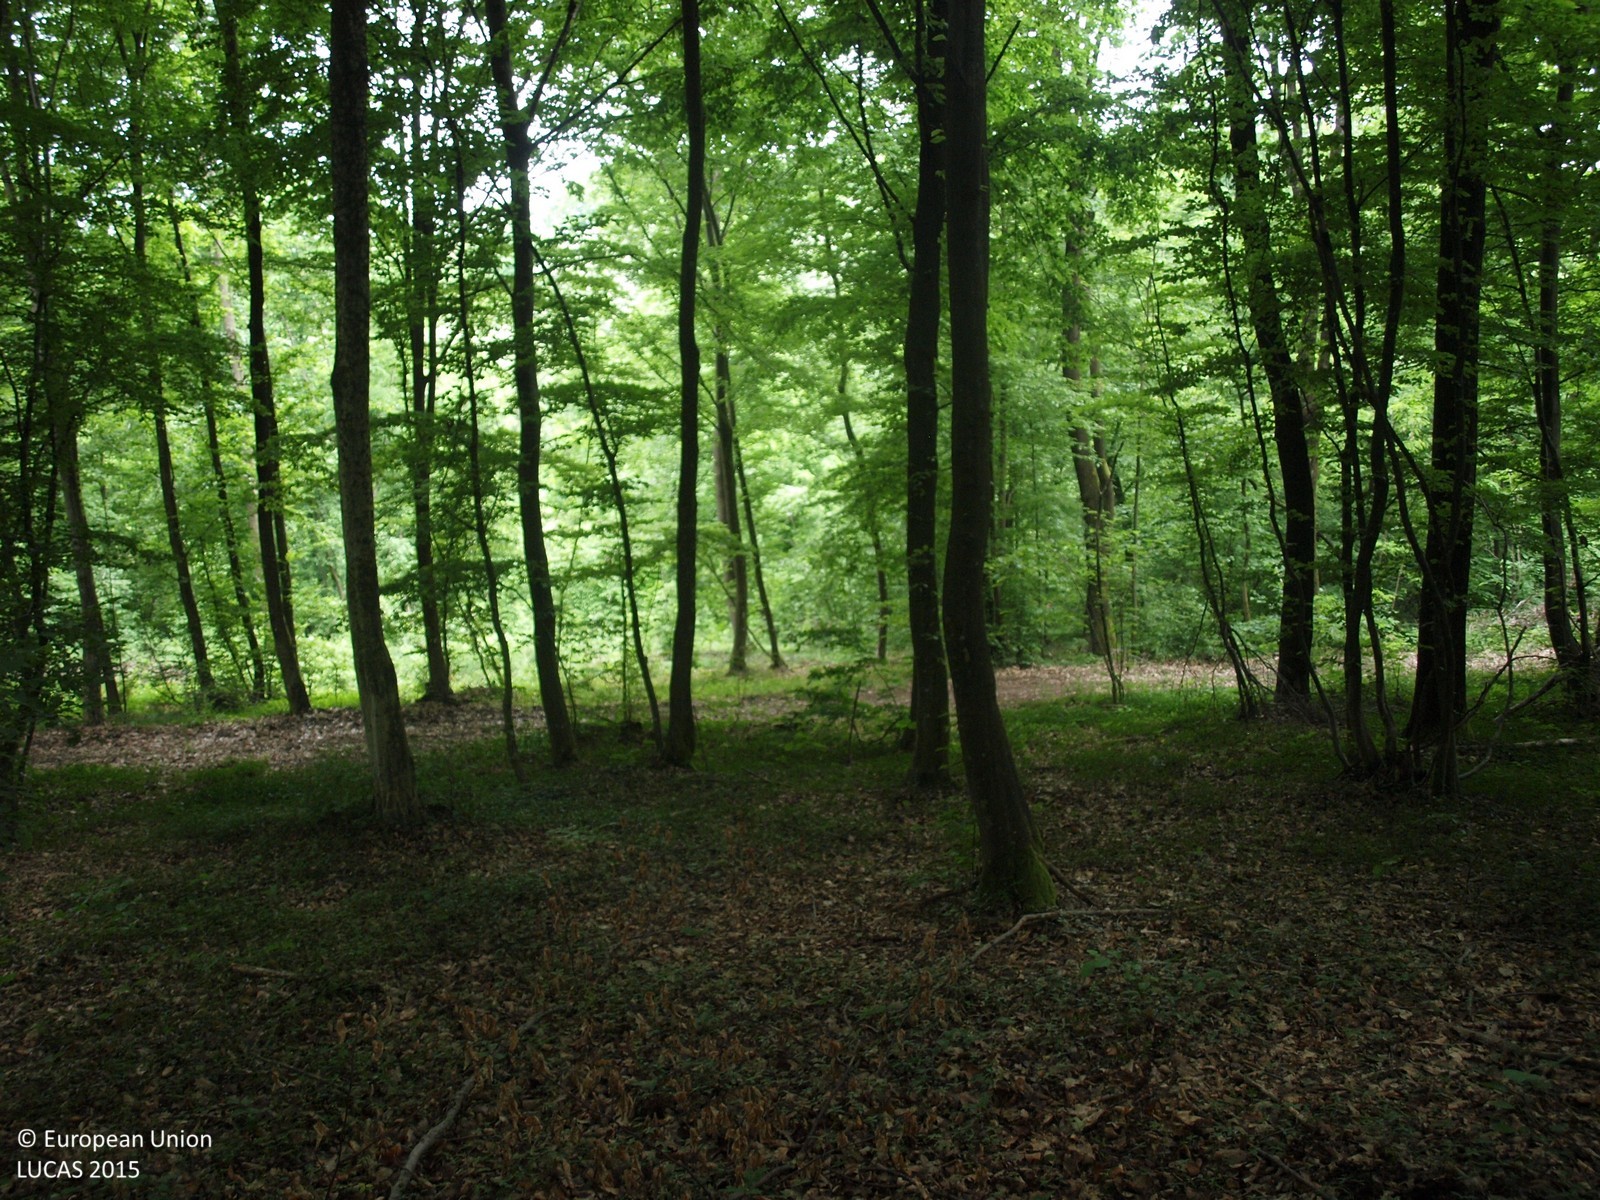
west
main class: Woodland
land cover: Broadleaved woodland
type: mesophytic deciduous forest
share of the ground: > 75 %
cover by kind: broadleaved forest trees 90 %, shrubs 5 %, herbaceous plants 5 %
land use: Forestry
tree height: > 5 m
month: May
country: HR
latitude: 46.1218
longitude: 16.1201
